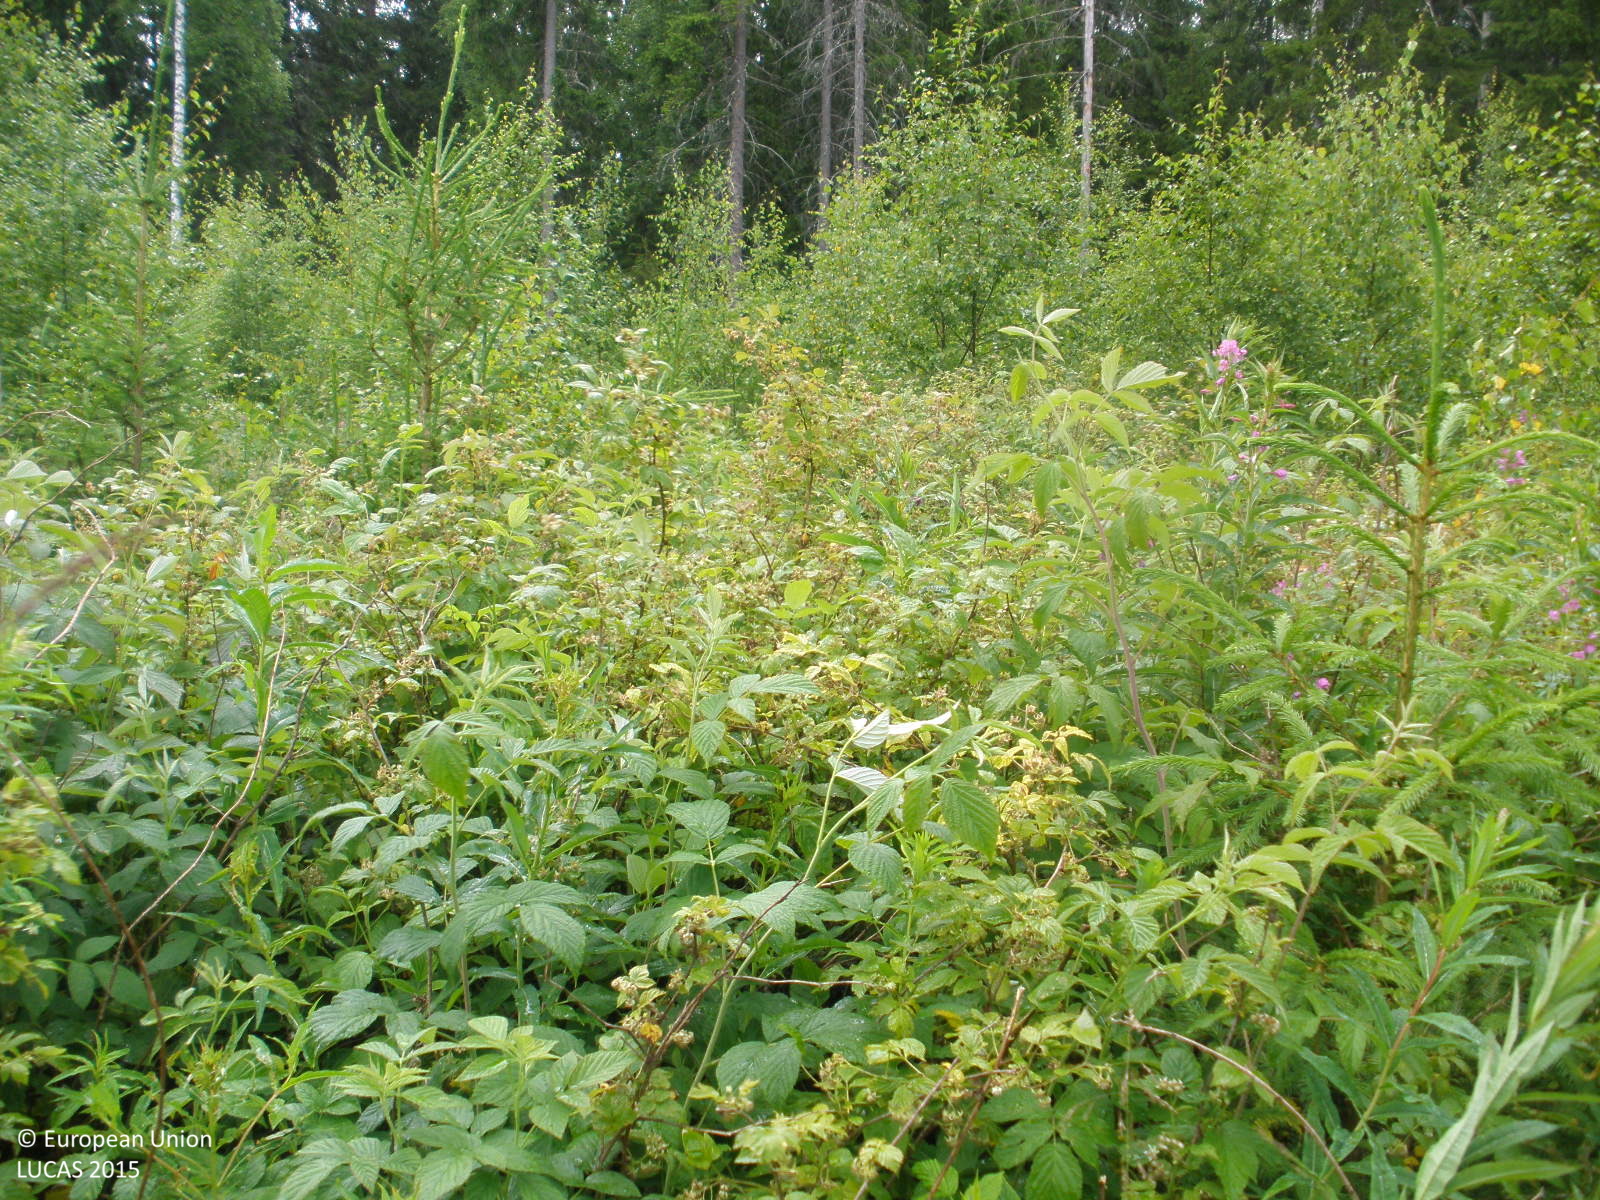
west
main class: Woodland
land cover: Other mixed woodland
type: boreal forest
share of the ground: 50 - 75 %
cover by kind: broadleaved forest trees 40 %, shrubs 35 %, coniferous forest trees 15 %, herbaceous plants 10 %
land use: Forestry
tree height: < 5 m
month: July
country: FI
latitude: 61.4213
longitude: 24.7398
